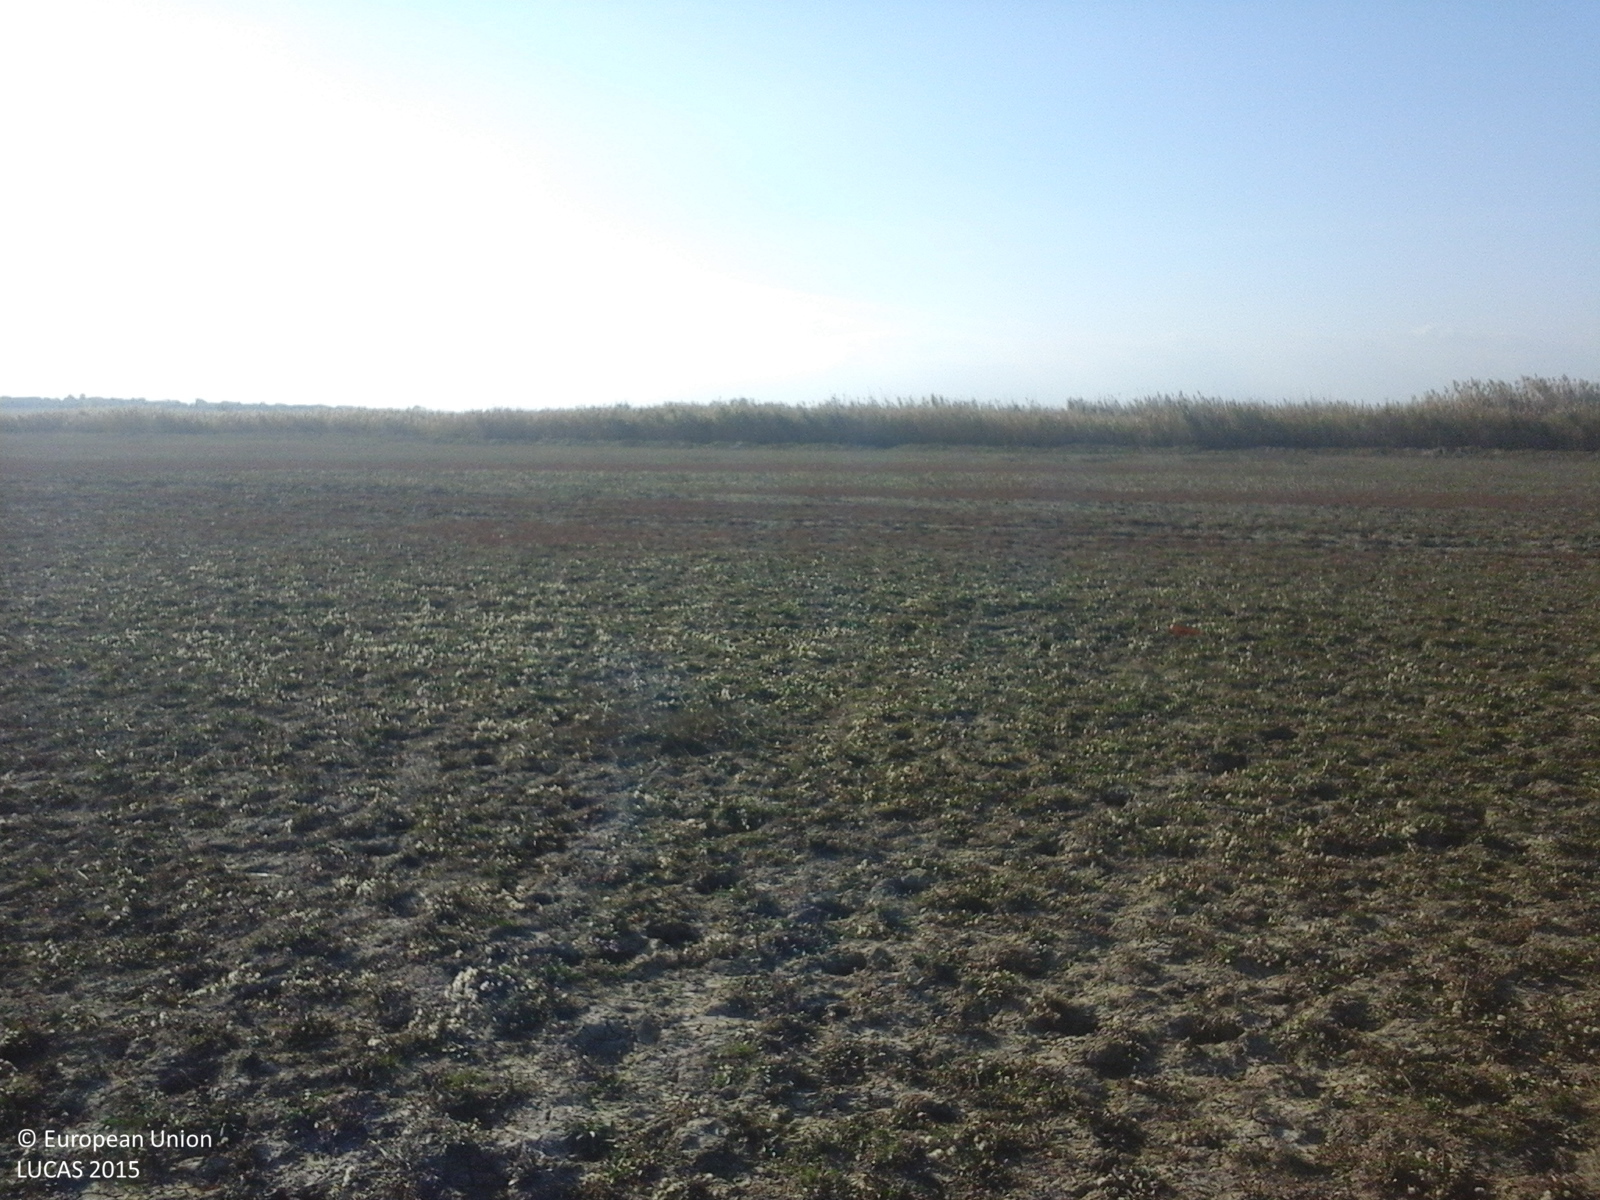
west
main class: Grassland
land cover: Grassland without tree/shrub cover
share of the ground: > 75 %
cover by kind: herbaceous plants 100 %
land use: Agriculture (excluding fallow land and kitchen gardens)
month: October
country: RO
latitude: 45.2181
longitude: 27.3241
